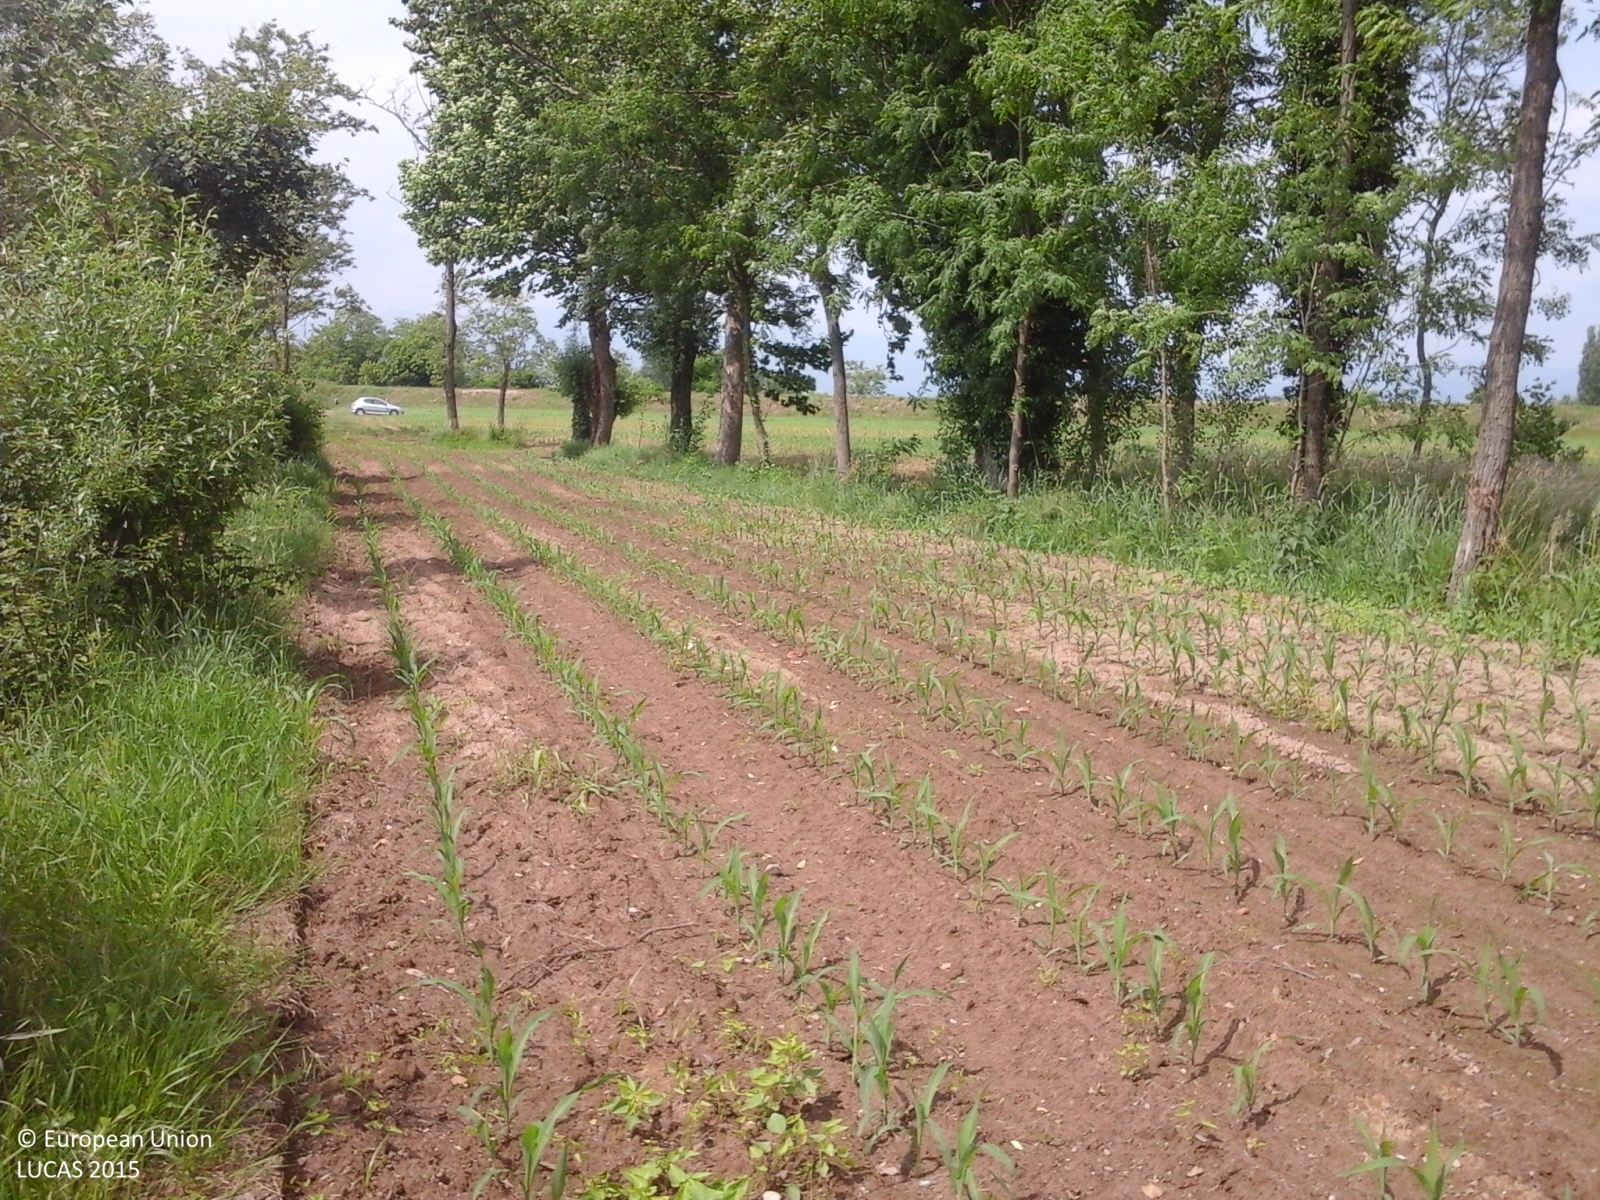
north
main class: Cropland
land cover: Soya
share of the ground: < 10 %
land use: Agriculture (excluding fallow land and kitchen gardens)
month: May
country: IT
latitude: 45.6196
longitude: 11.5237
